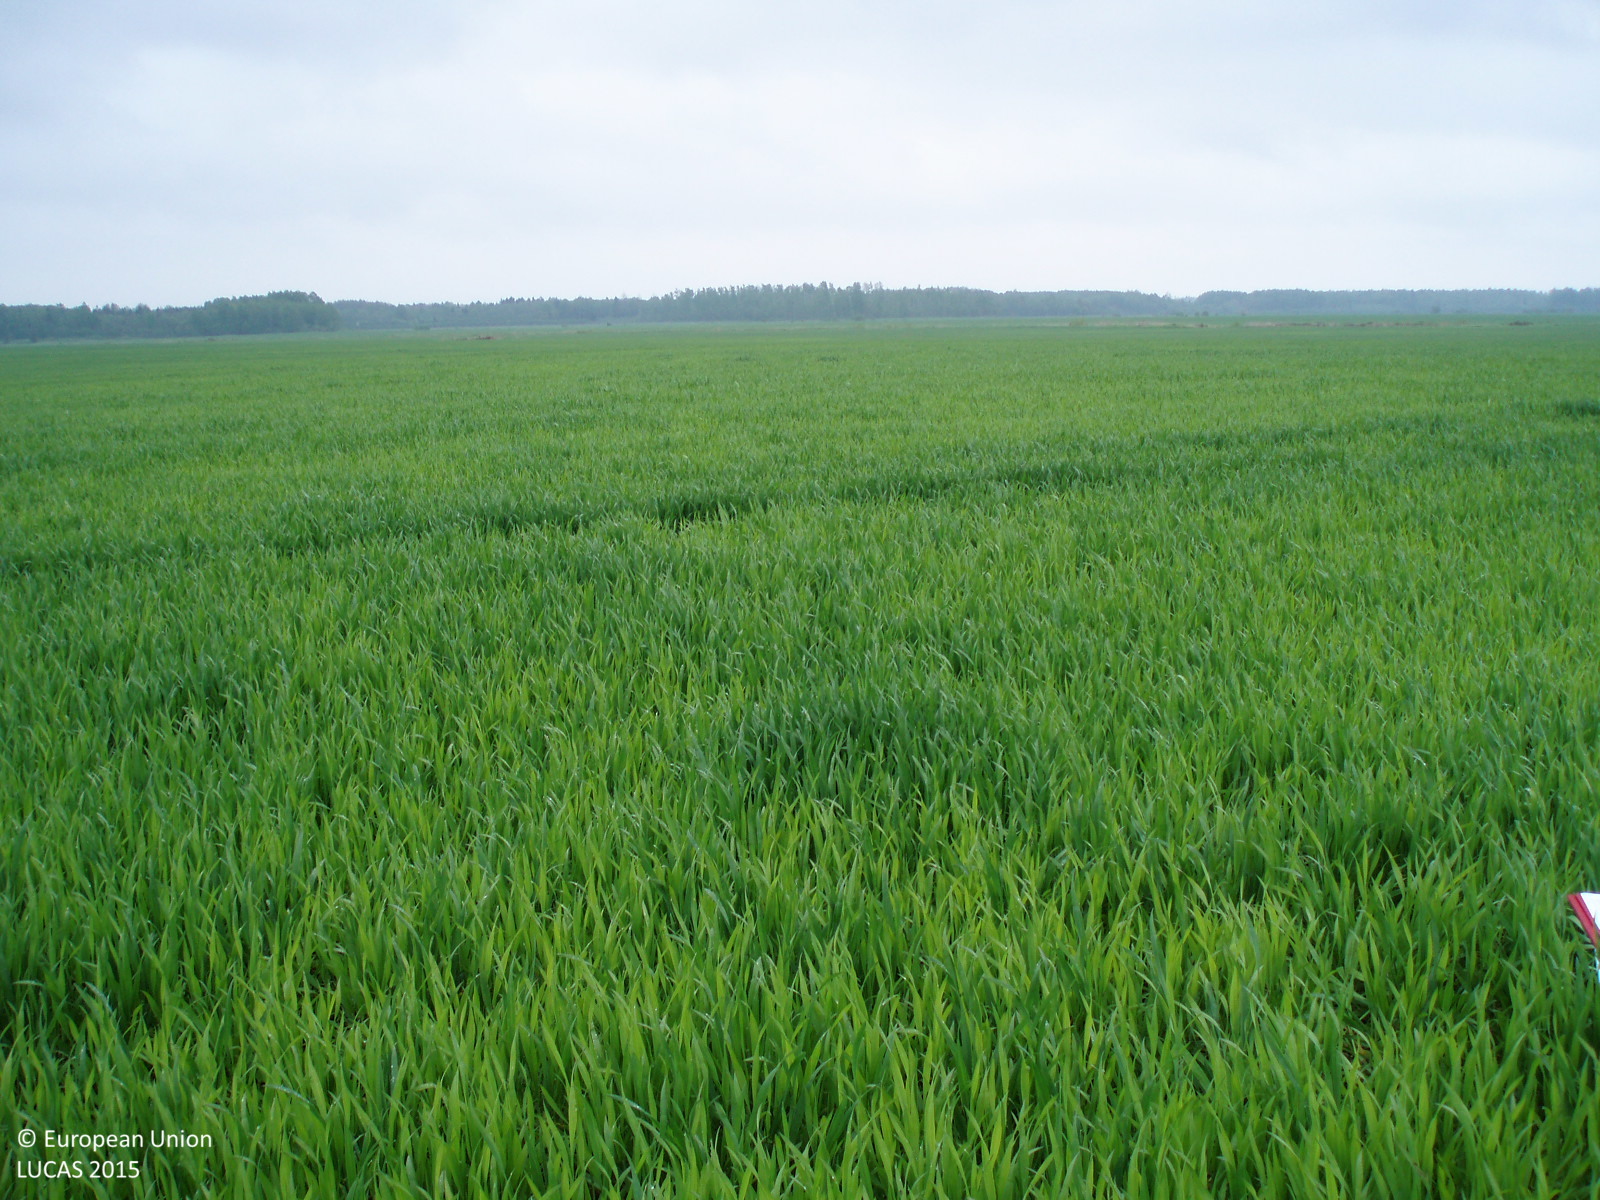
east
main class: Cropland
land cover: Common wheat
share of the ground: > 75 %
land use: Agriculture (excluding fallow land and kitchen gardens)
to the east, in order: Common wheat
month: May
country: LT
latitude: 56.4004
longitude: 22.9795
